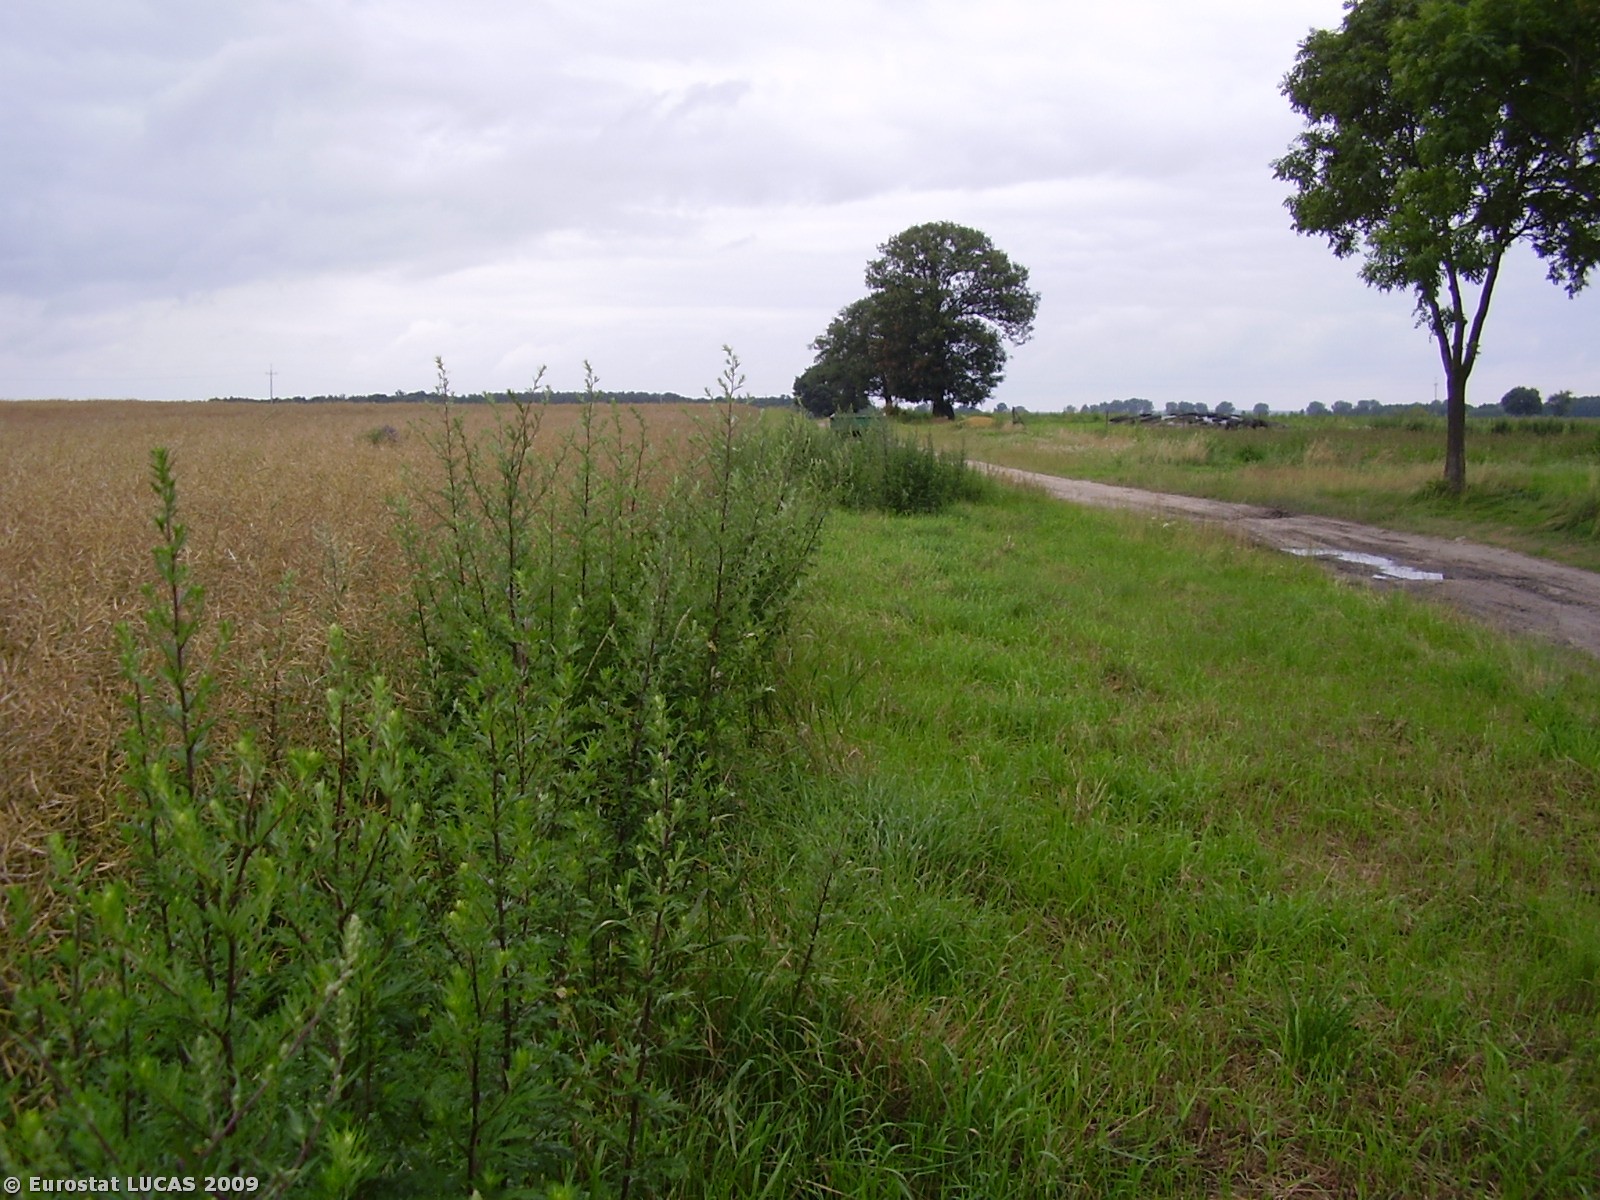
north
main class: Cropland
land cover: Rape and turnip rape
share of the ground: > 75 %
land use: Agriculture (excluding fallow land and kitchen gardens)
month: July
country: PL
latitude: 51.1901
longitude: 17.6688
